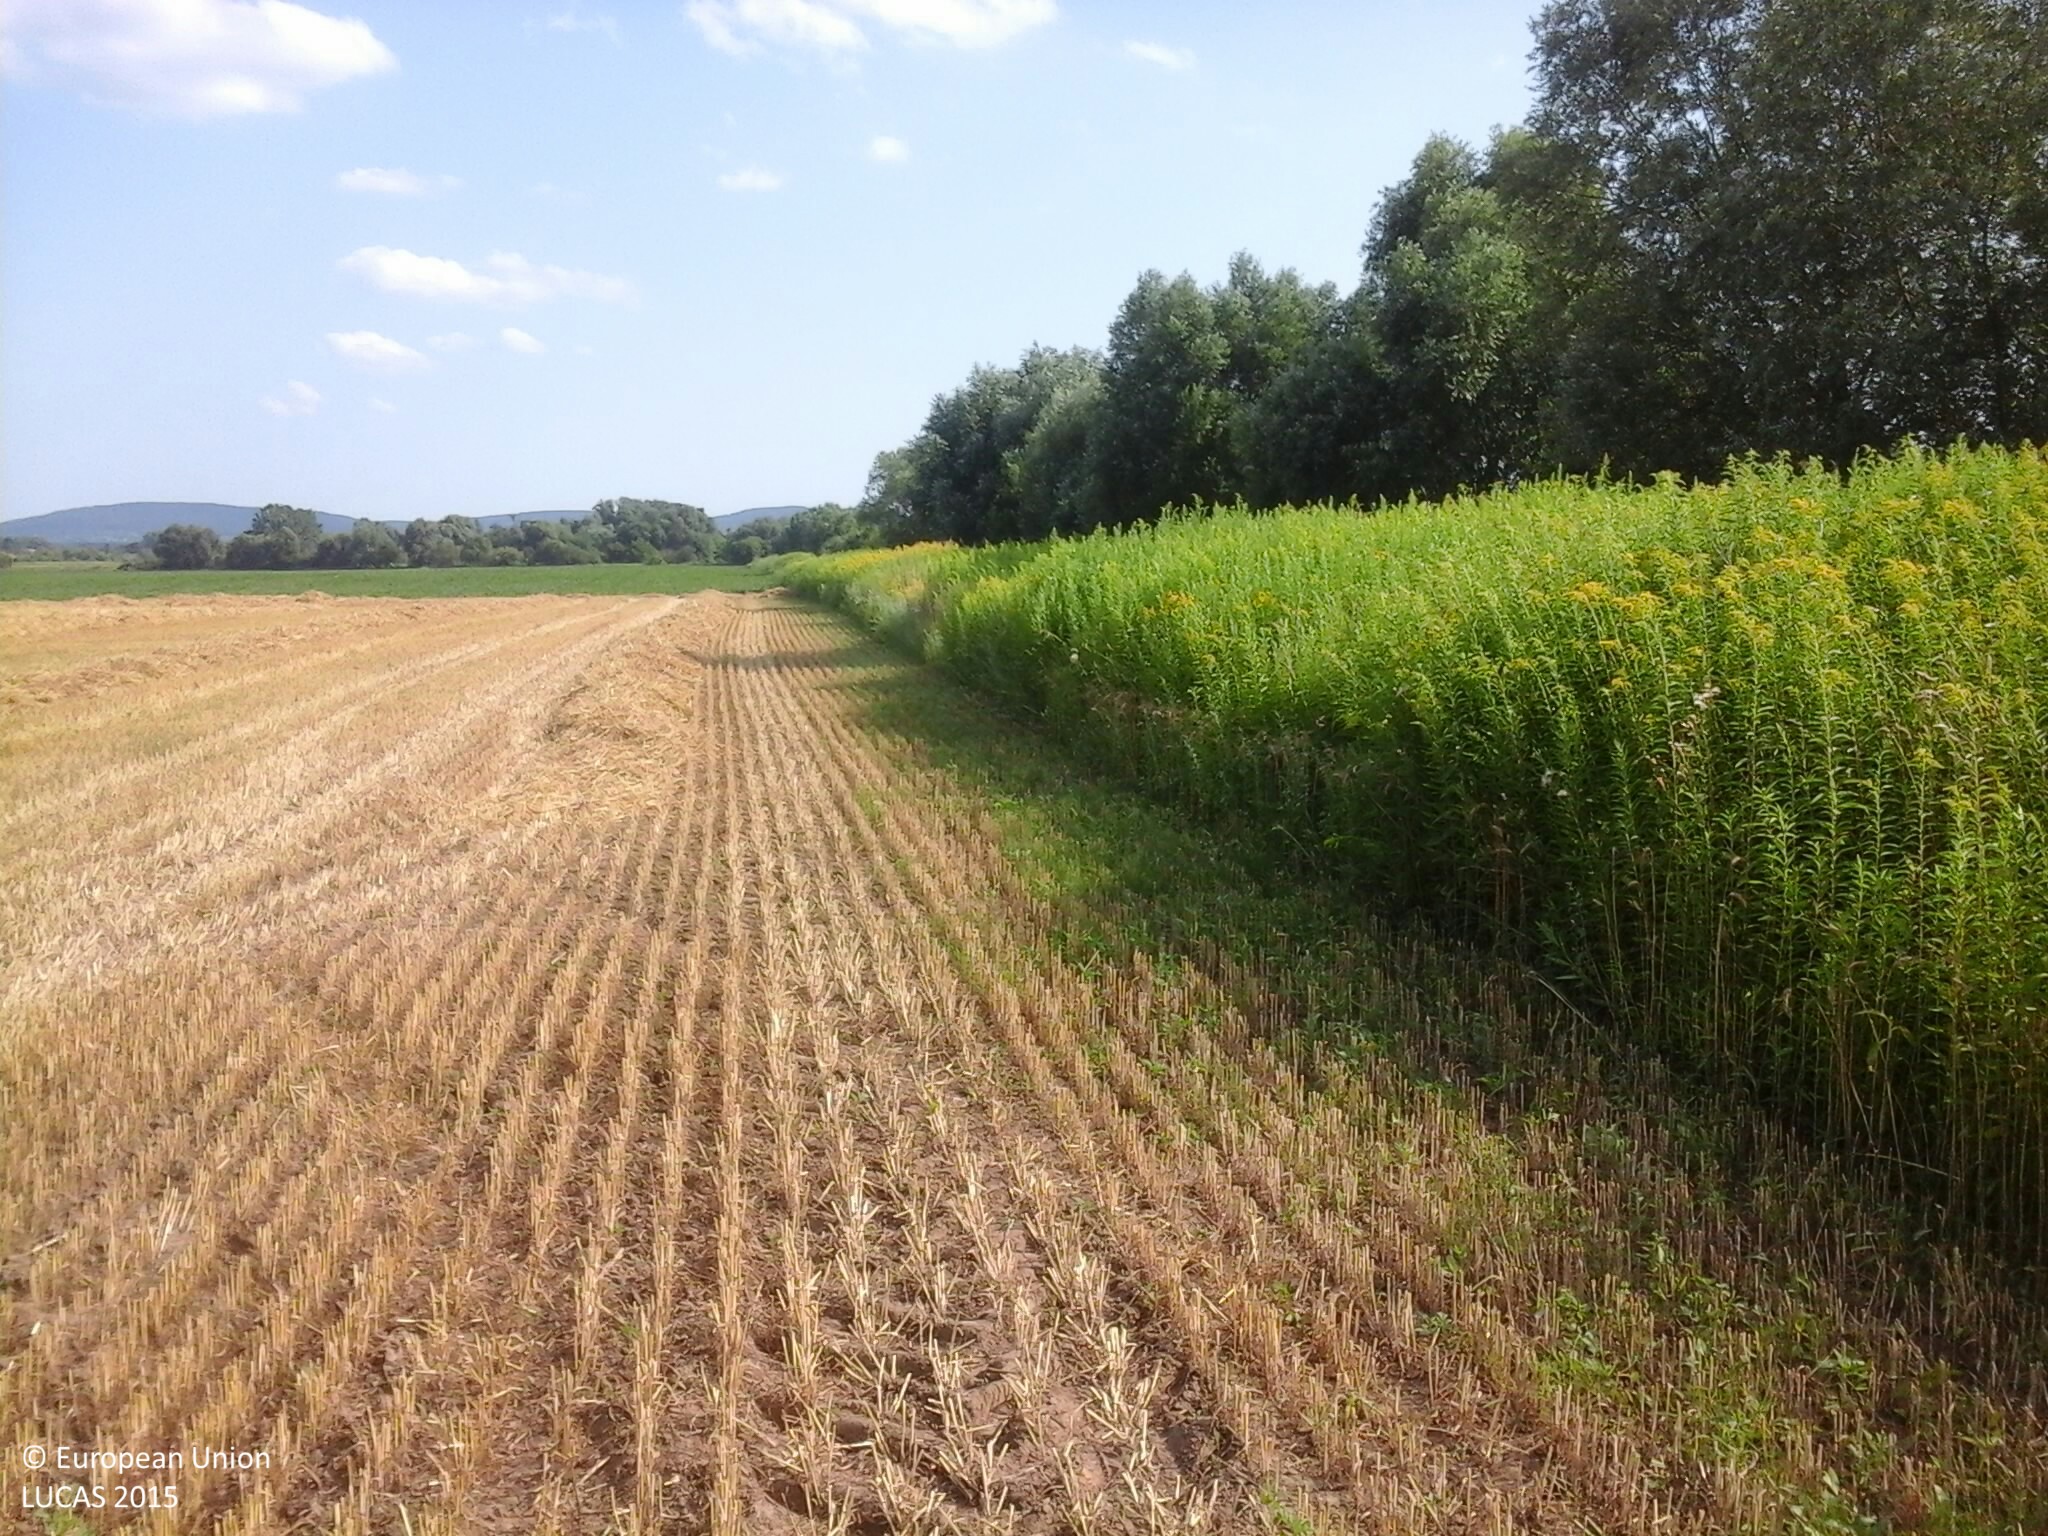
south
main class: Grassland
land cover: Spontaneously vegetated surfaces
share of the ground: > 75 %
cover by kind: herbaceous plants 100 %
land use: Semi-natural and natural areas not in use
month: July
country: HU
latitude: 46.9961
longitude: 17.1719
